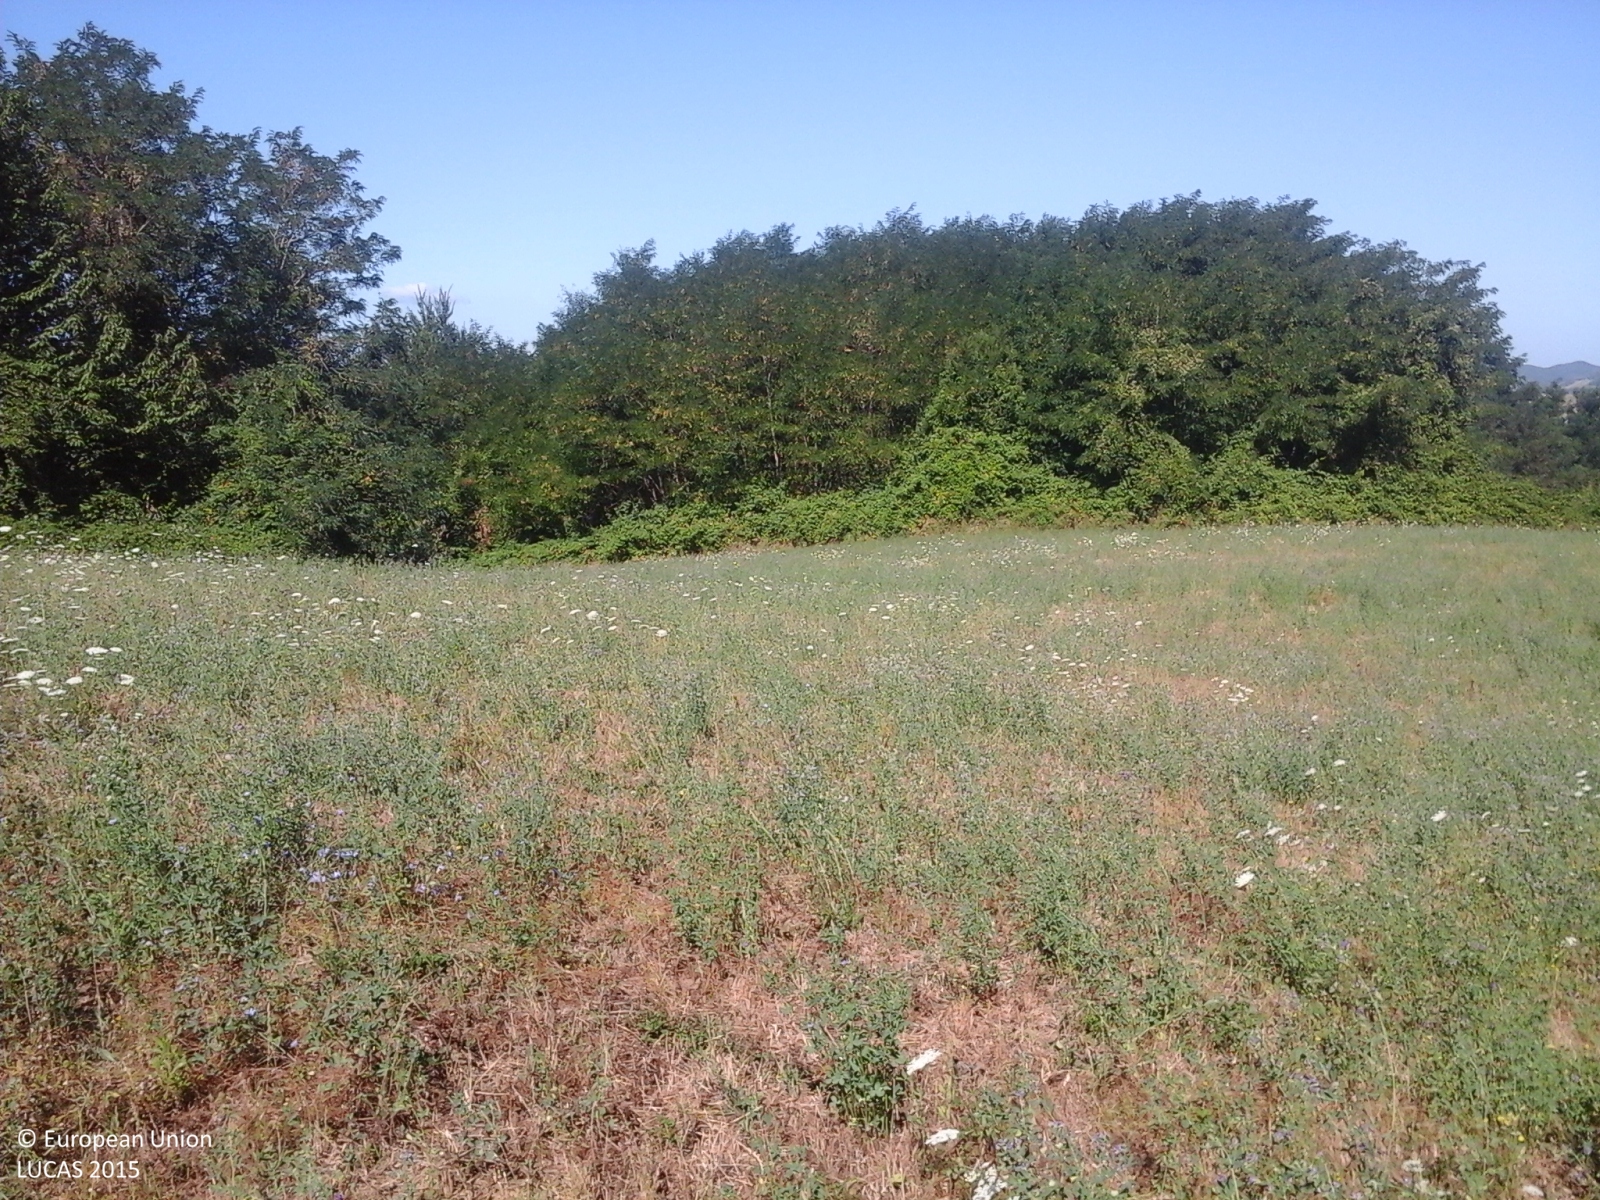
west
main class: Cropland
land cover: Lucerne
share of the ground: > 75 %
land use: Agriculture (excluding fallow land and kitchen gardens)
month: July
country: IT
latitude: 43.9117
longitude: 12.2236
